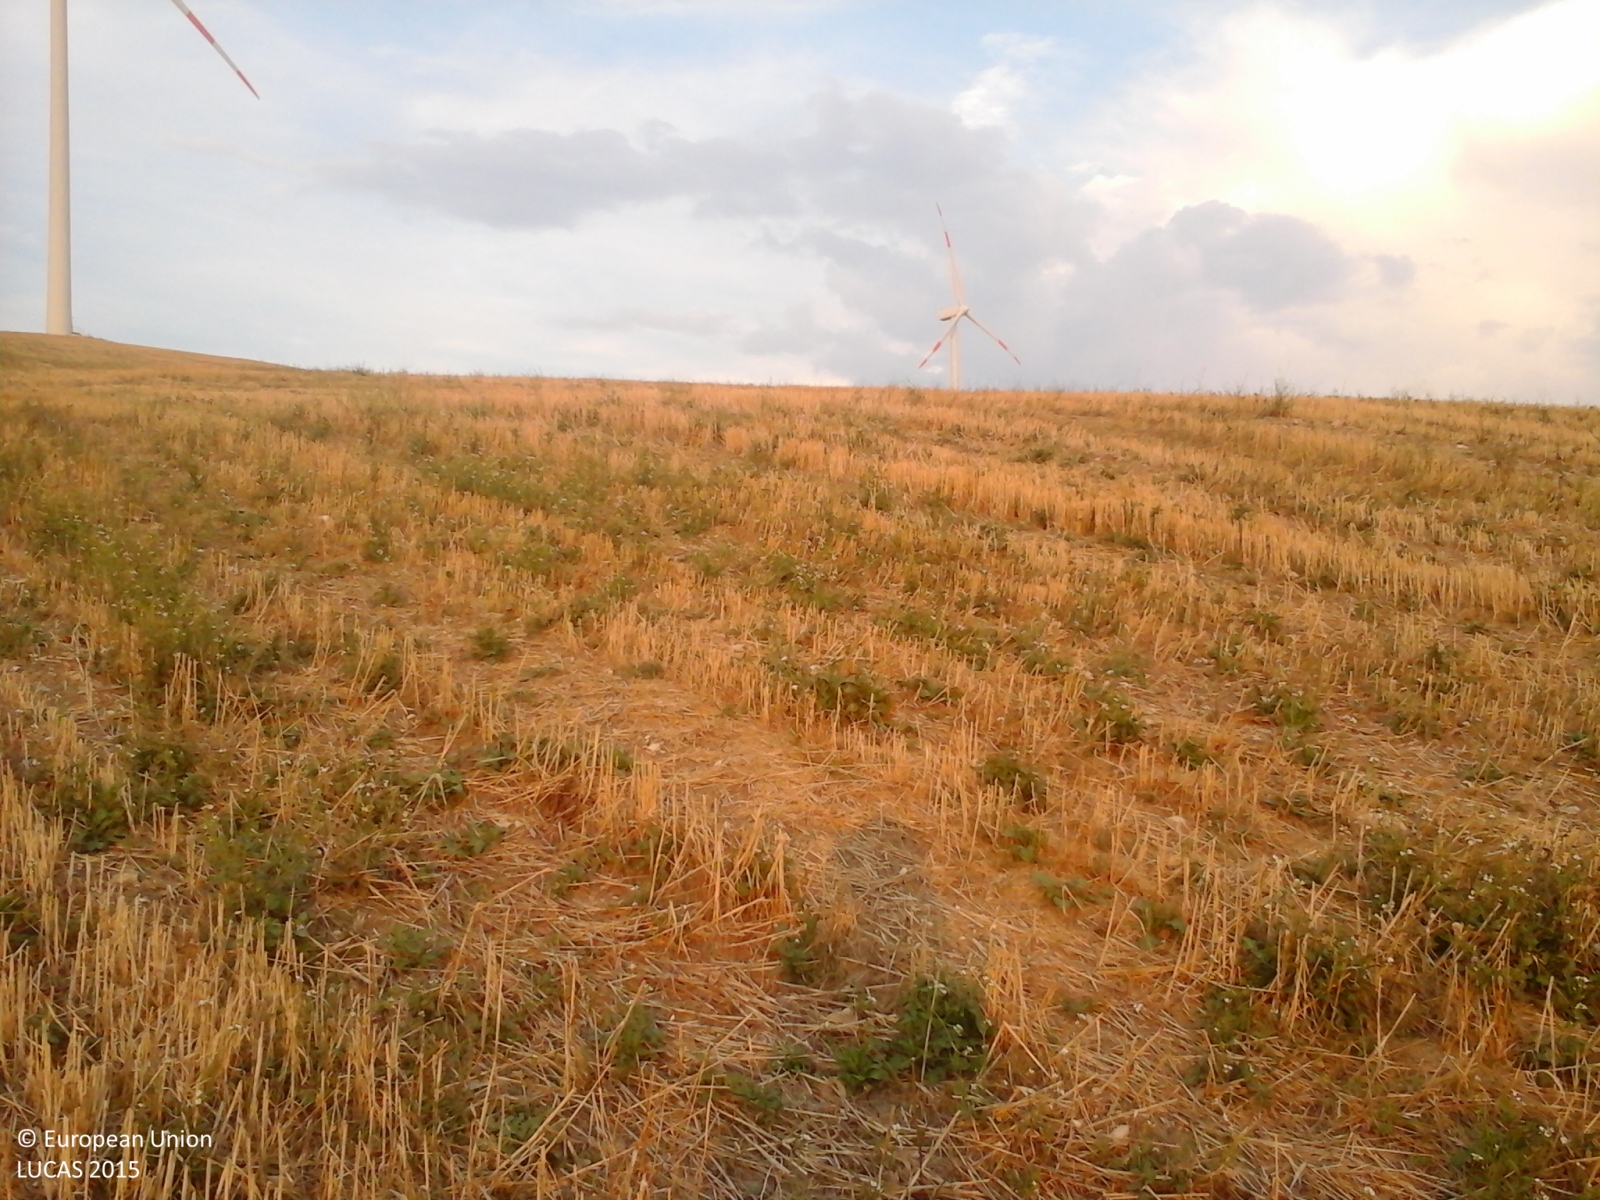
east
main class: Cropland
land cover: Durum wheat
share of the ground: > 75 %
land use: Agriculture (excluding fallow land and kitchen gardens)
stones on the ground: 10 - 25 %
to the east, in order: Durum wheat
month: August
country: IT
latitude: 41.3111
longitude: 15.1301
